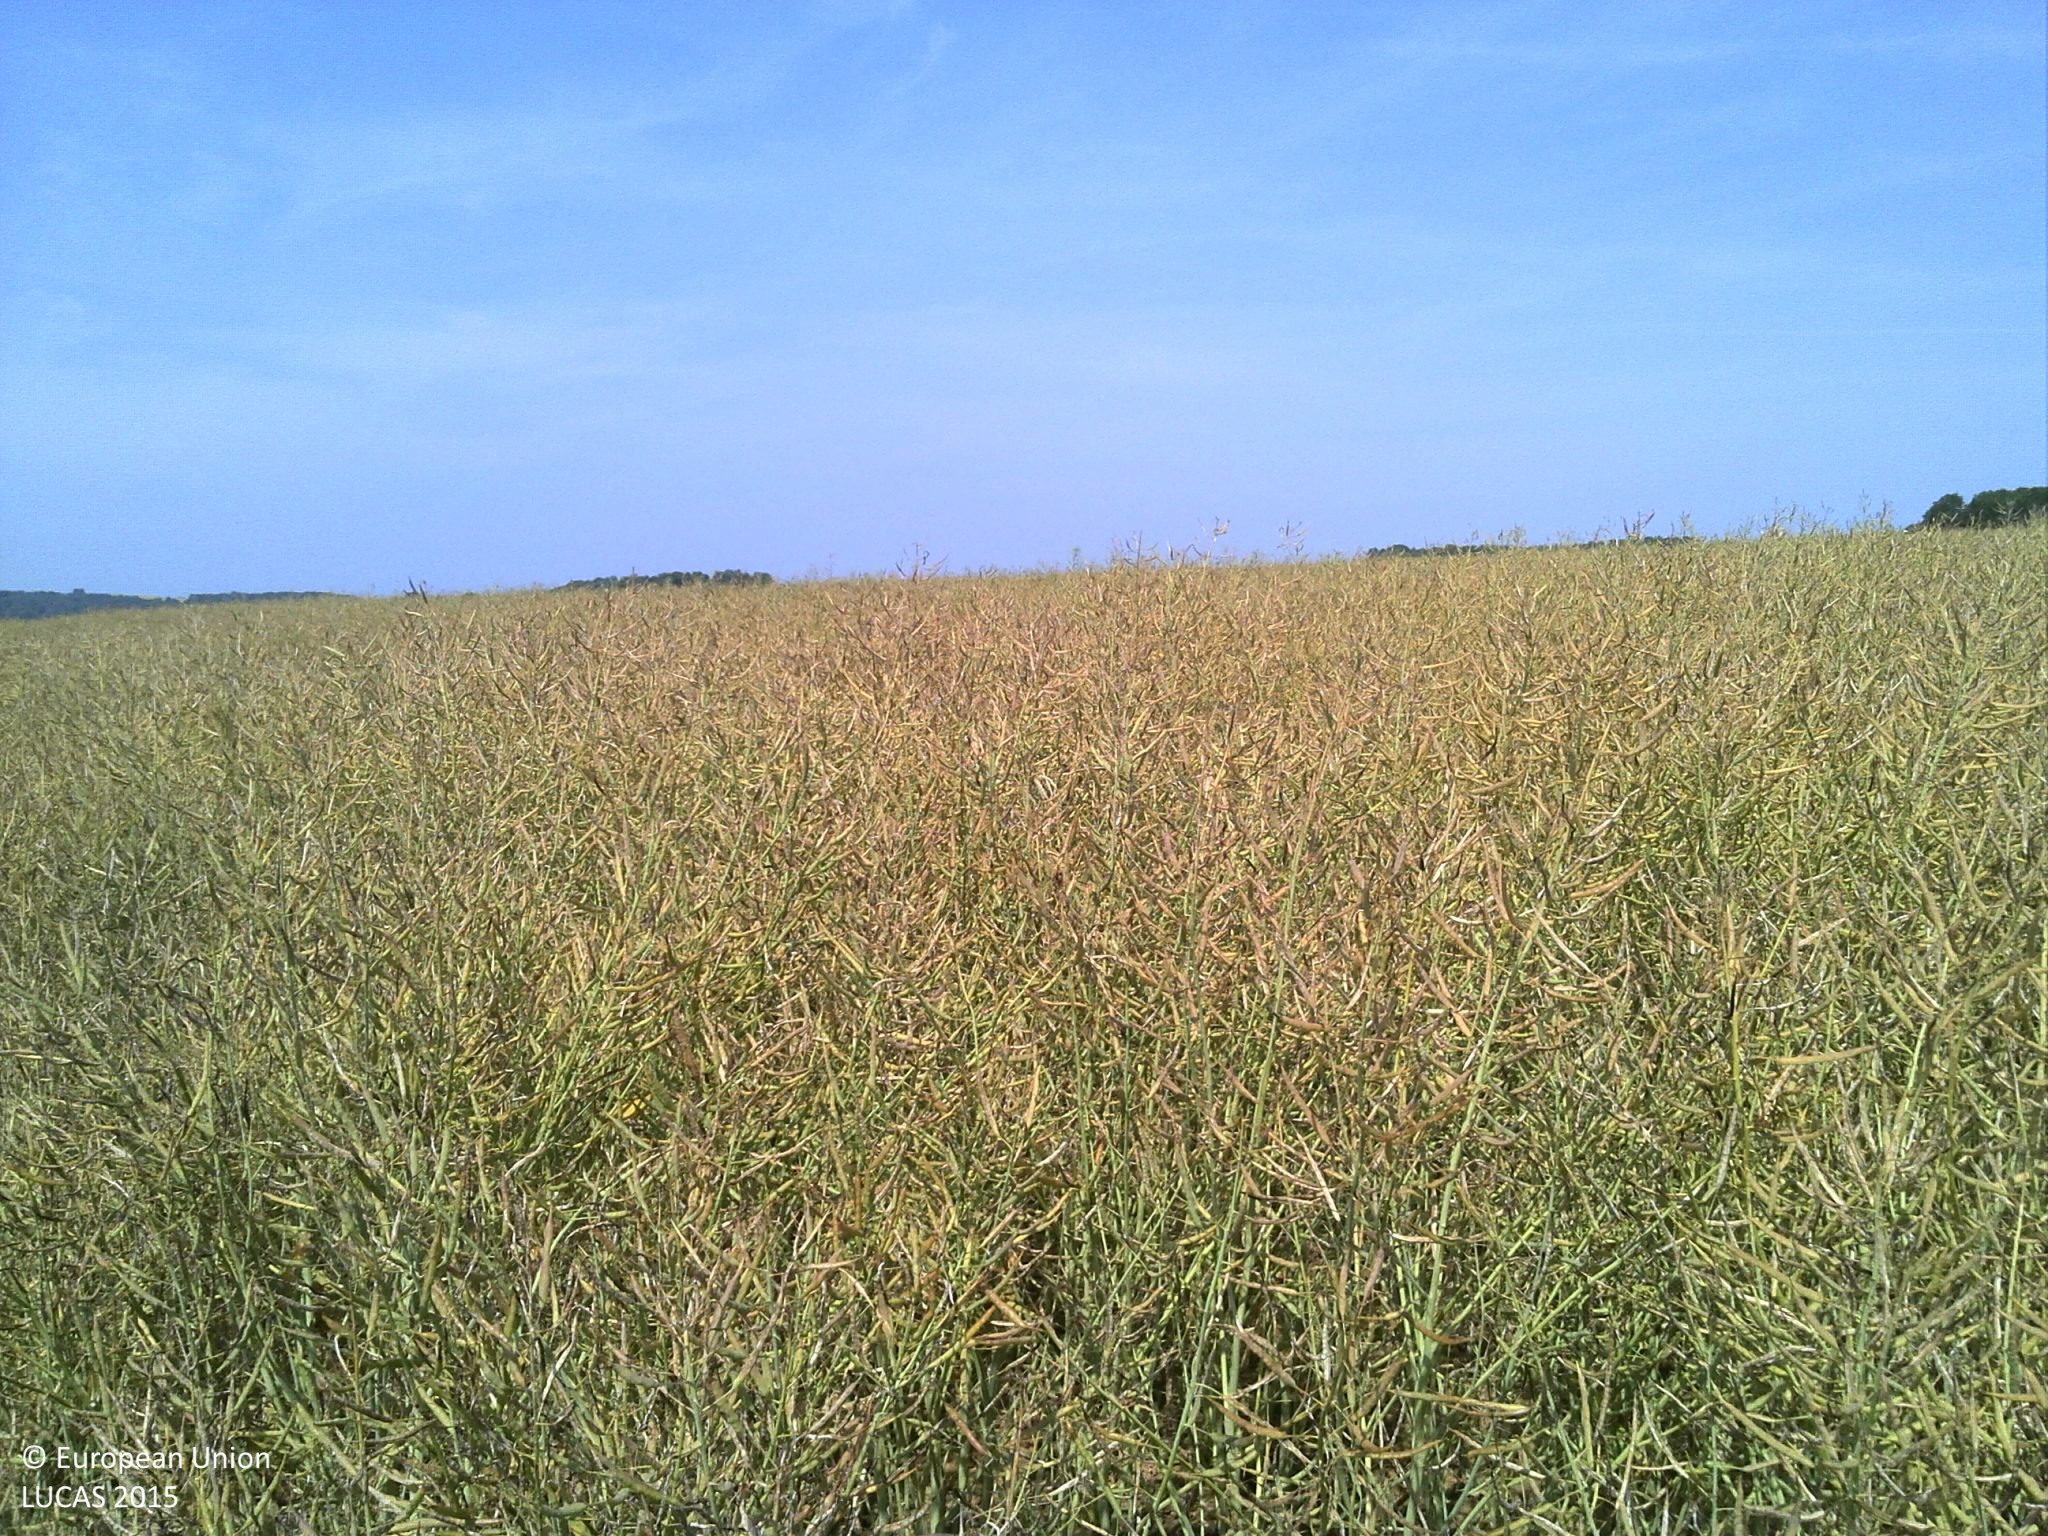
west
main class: Cropland
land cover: Rape and turnip rape
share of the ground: > 75 %
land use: Agriculture (excluding fallow land and kitchen gardens)
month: July
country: FR
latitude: 49.7790
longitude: 4.4549
